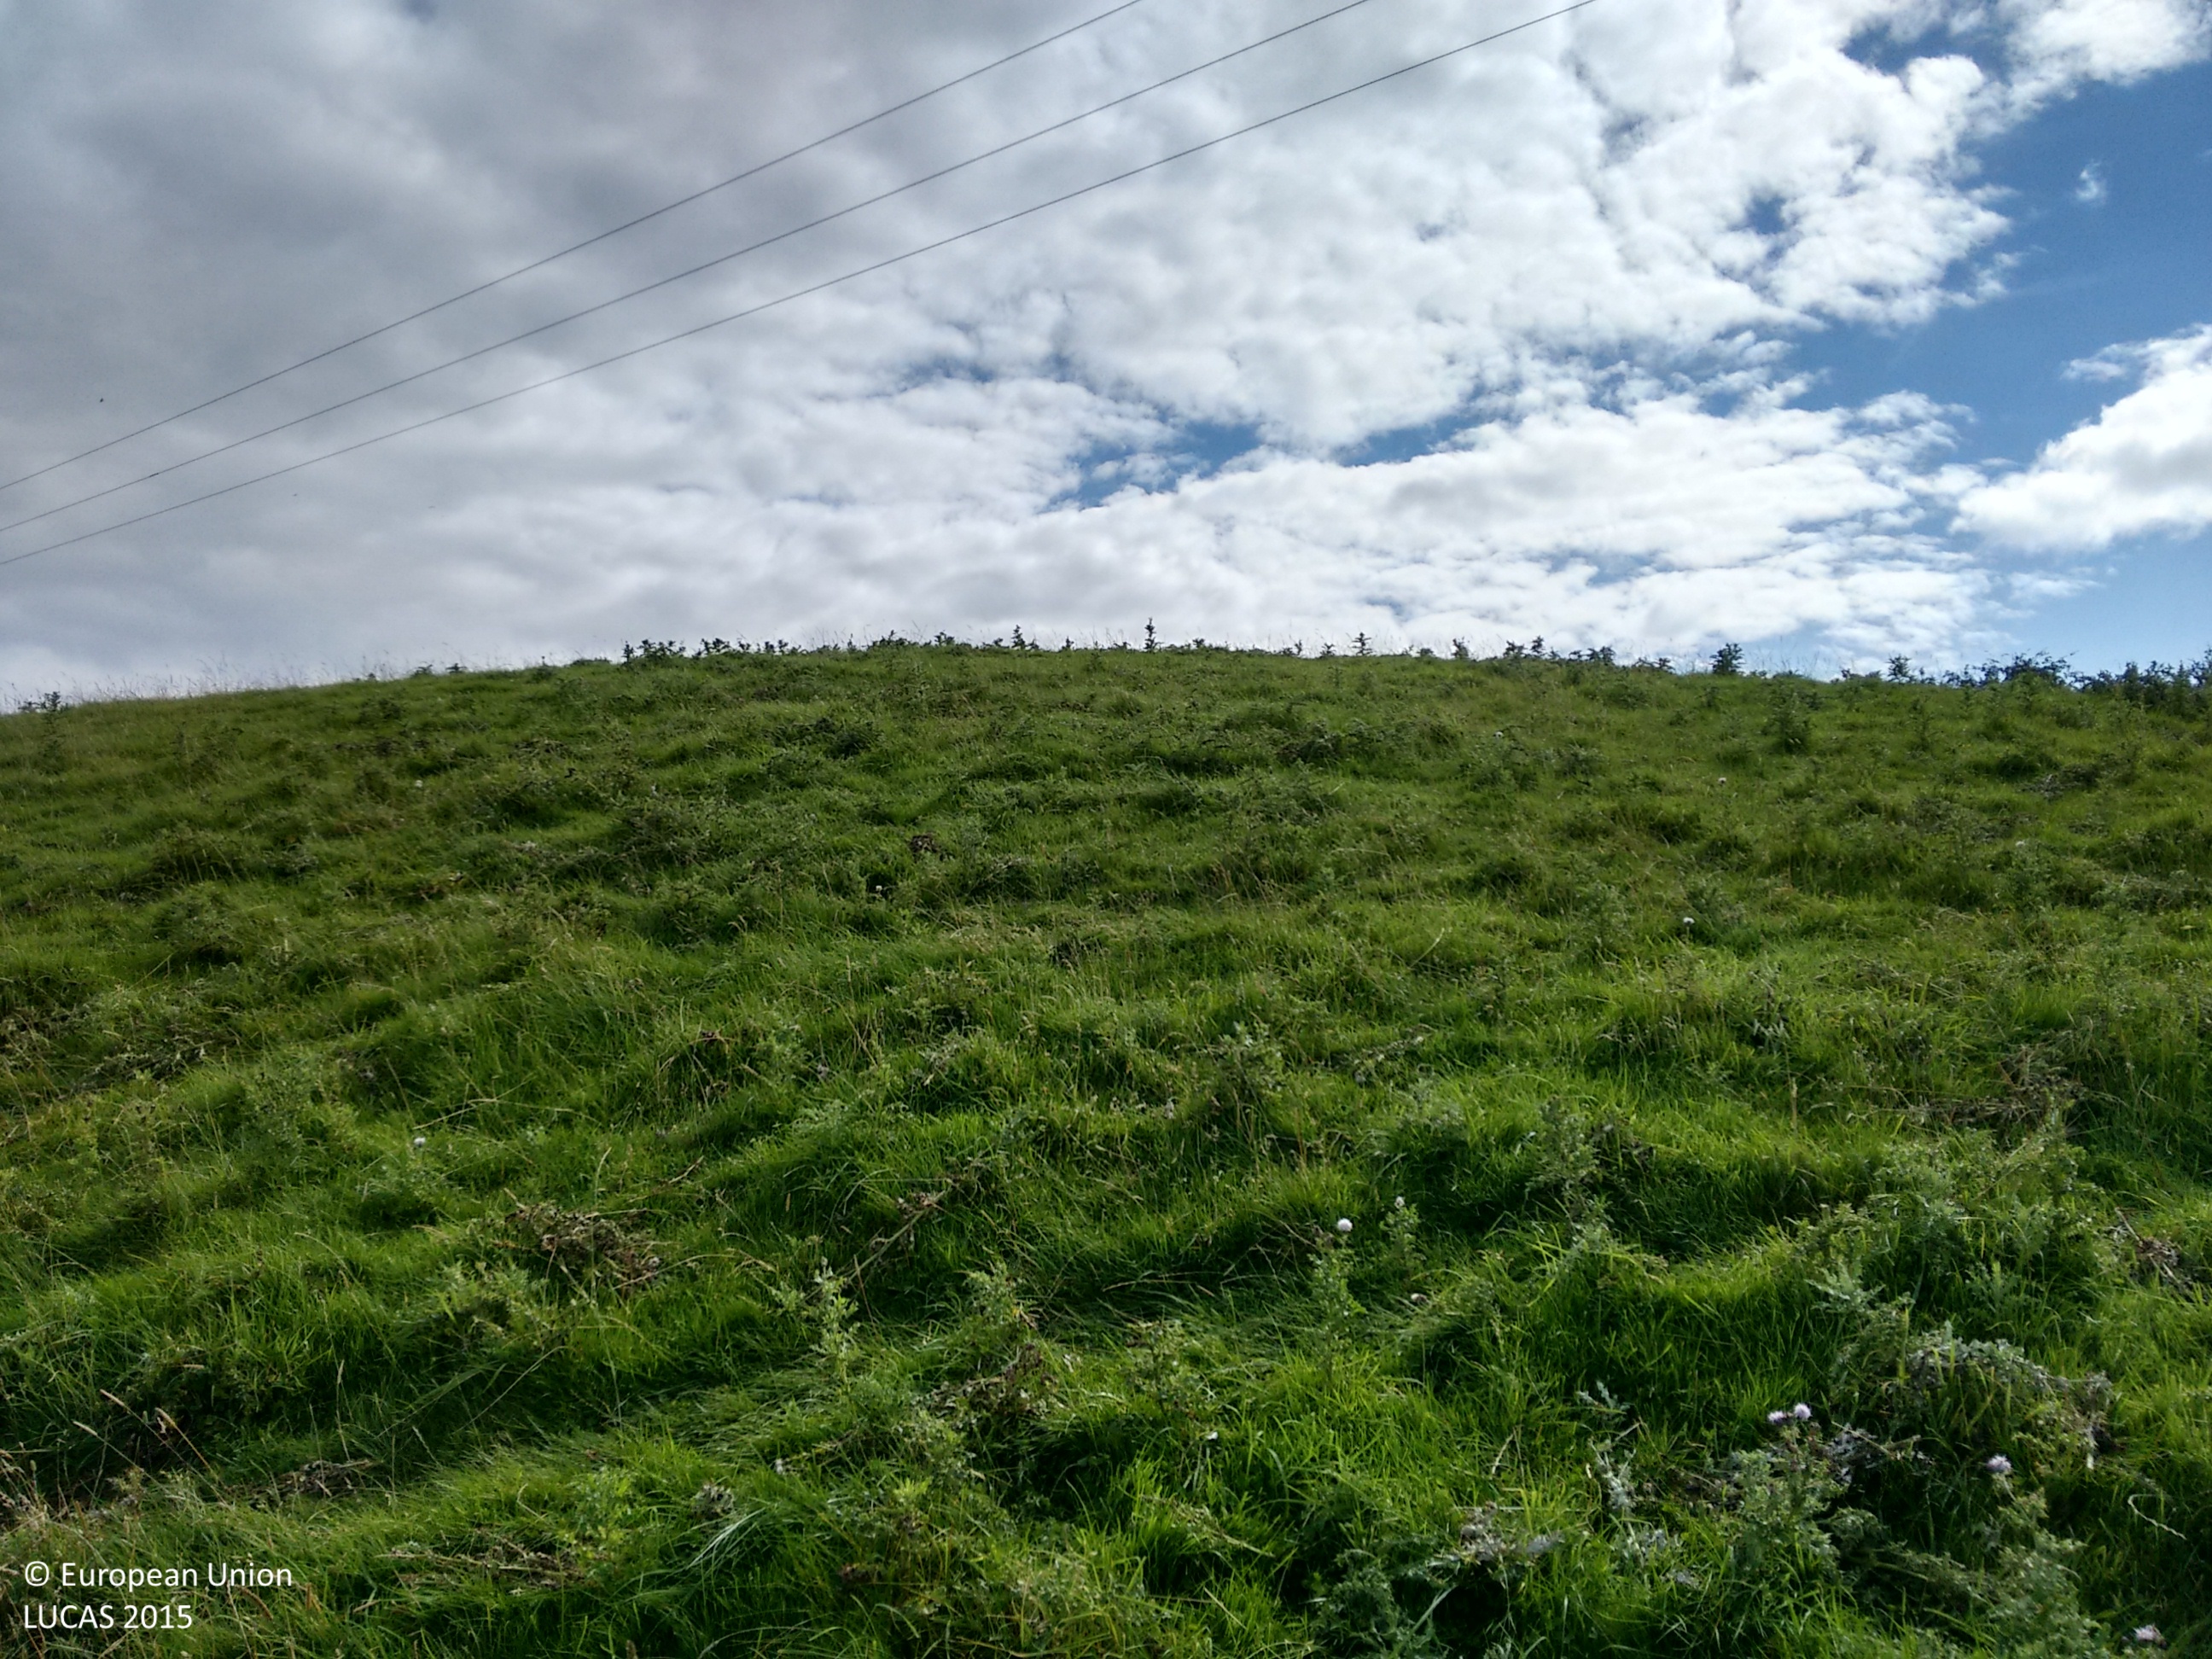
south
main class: Grassland
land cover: Grassland without tree/shrub cover
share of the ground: > 75 %
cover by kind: herbaceous plants 100 %
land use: Agriculture (excluding fallow land and kitchen gardens)
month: August
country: IE
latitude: 53.3507
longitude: -7.6030
